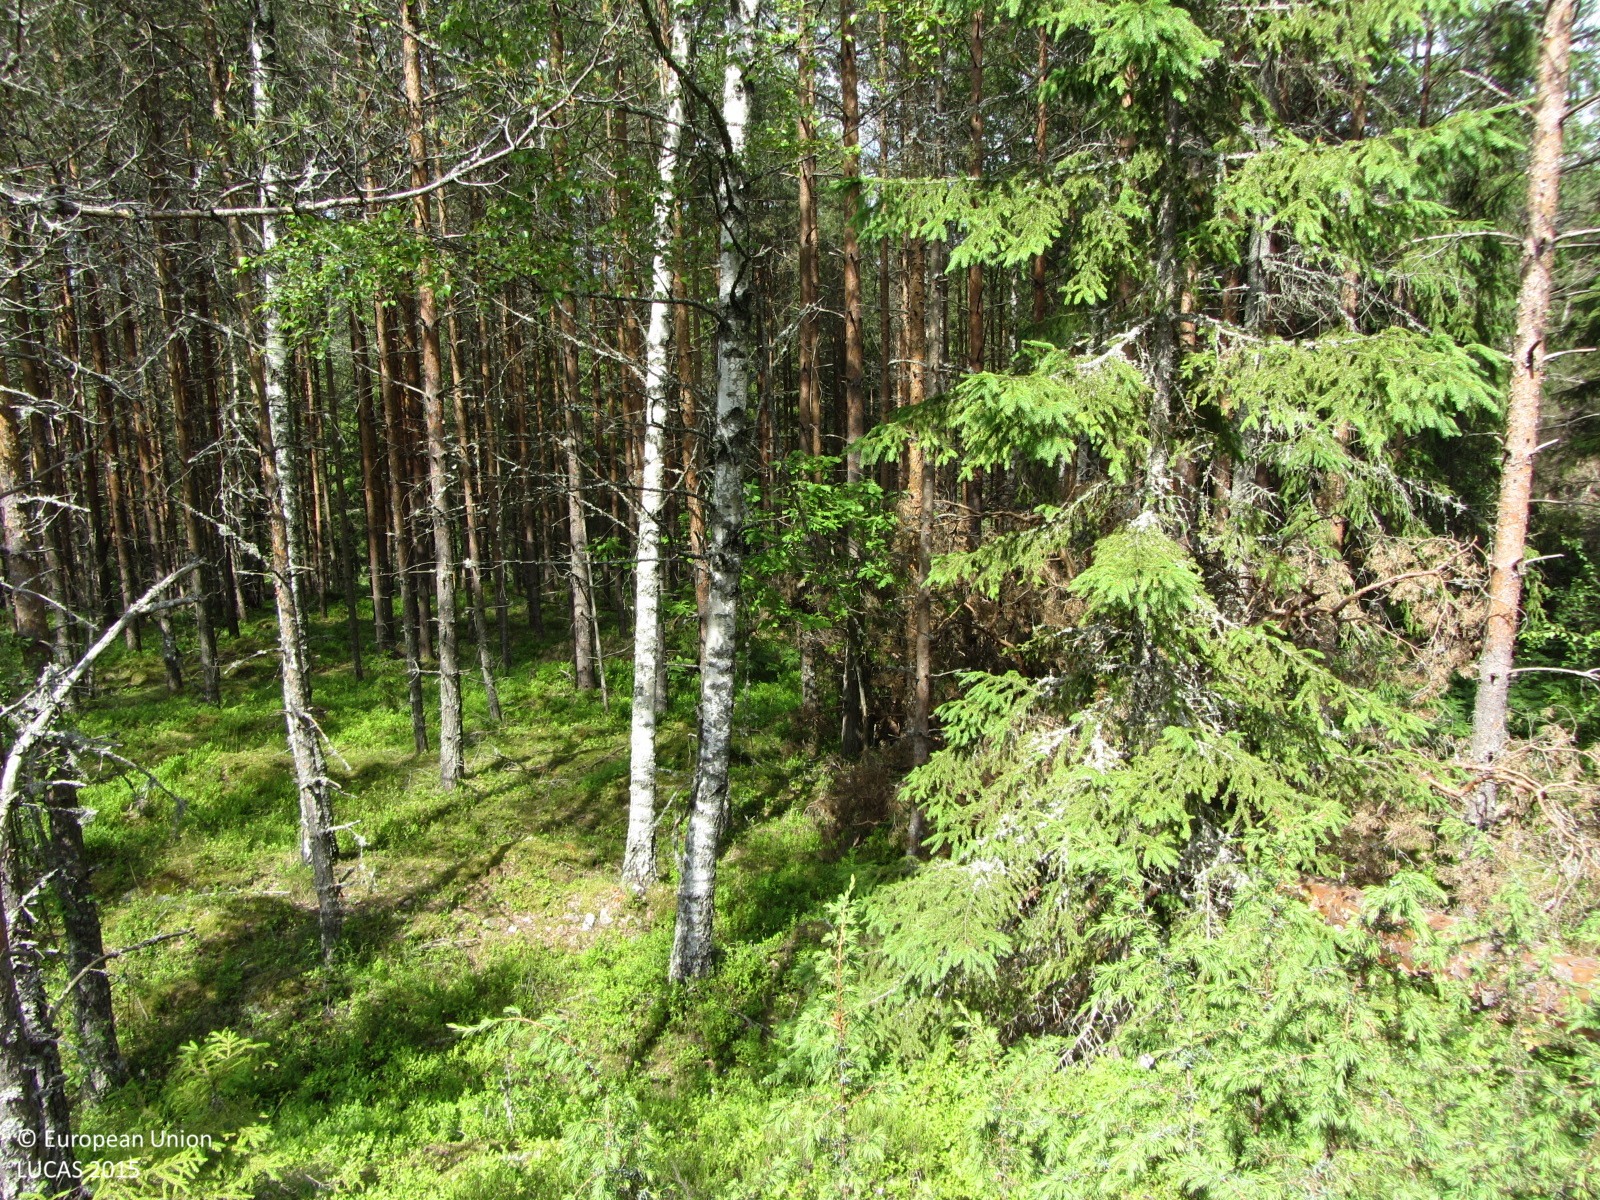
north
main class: Woodland
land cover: Pine dominated mixed woodland
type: boreal forest
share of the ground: 50 - 75 %
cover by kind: coniferous forest trees 45 %, shrubs 20 %, lichens and mosses 20 %, broadleaved forest trees 15 %
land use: Forestry
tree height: > 5 m
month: June
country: FI
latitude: 60.1267
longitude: 23.1686
